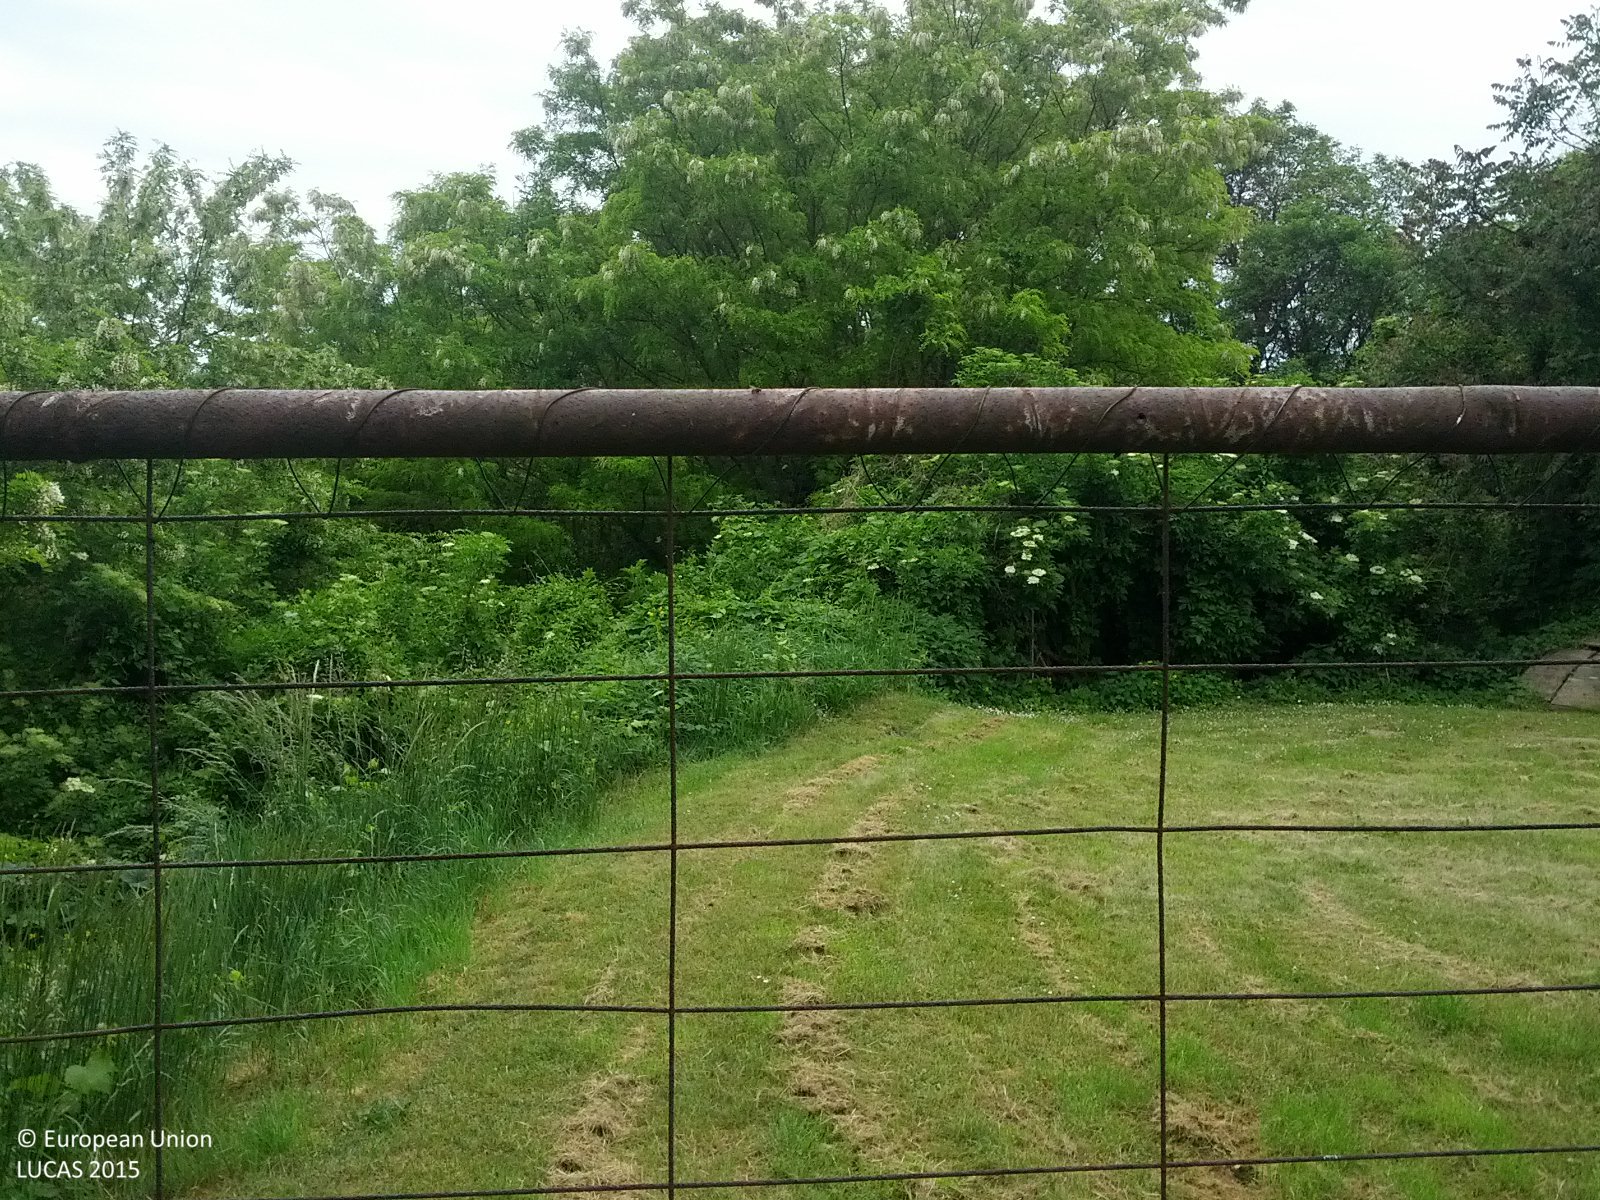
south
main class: Woodland
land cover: Broadleaved woodland
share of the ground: 25 - 50 %
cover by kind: herbaceous plants 50 %, broadleaved forest trees 45 %, shrubs 5 %
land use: Residential
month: May
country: AT
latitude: 48.1111
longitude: 16.6814
